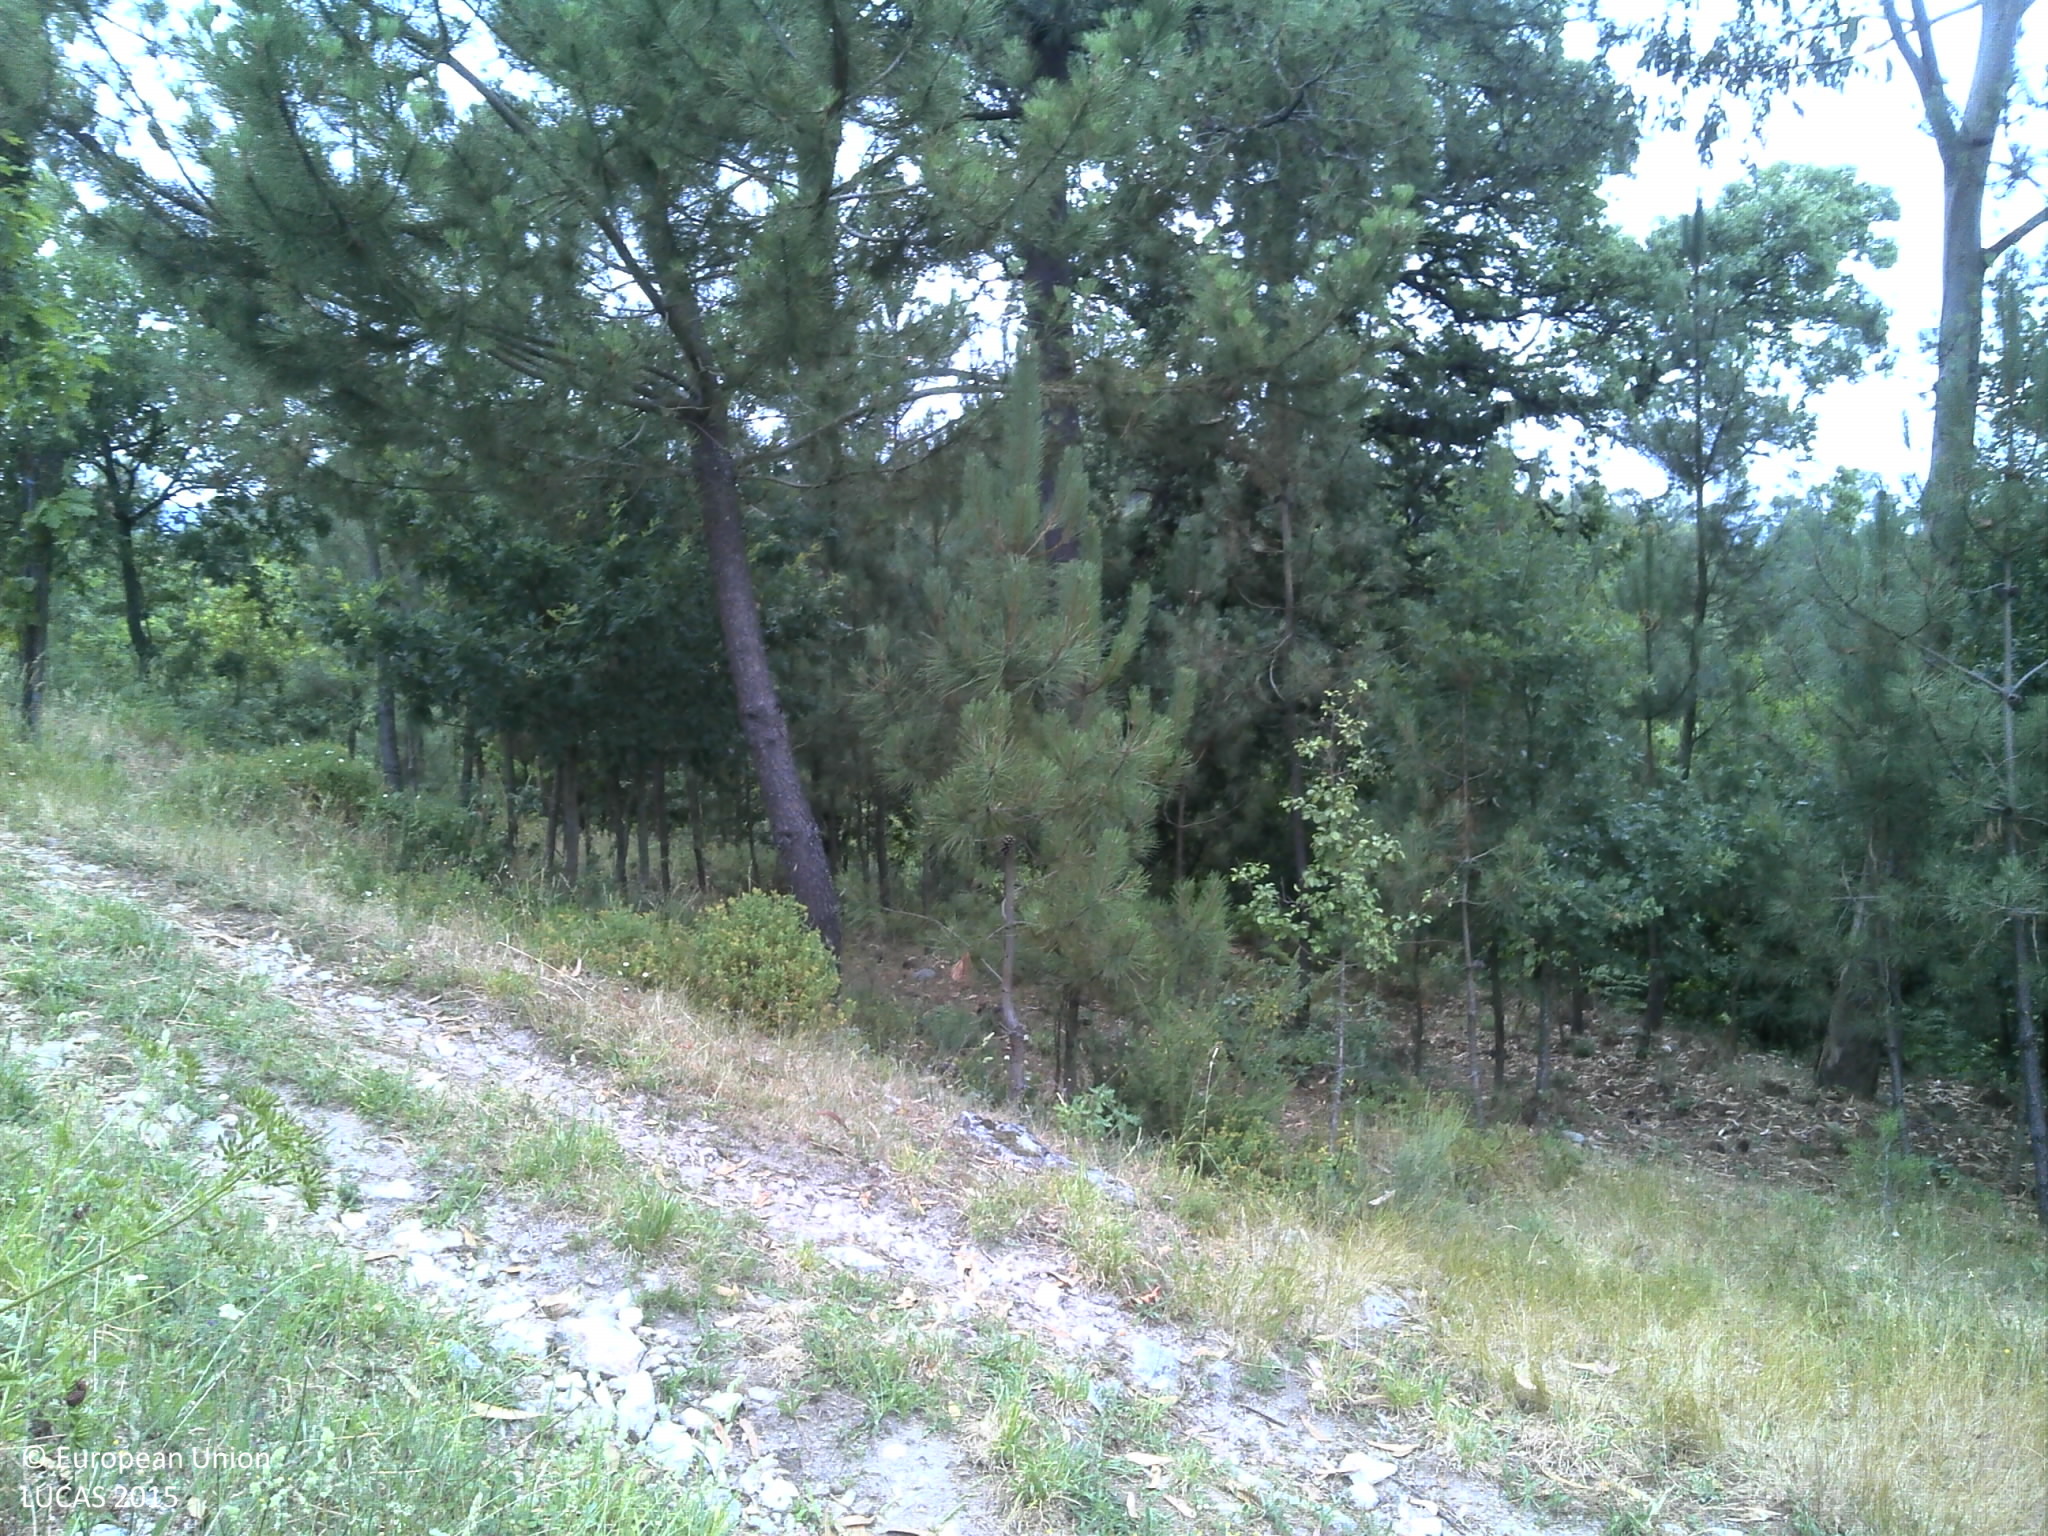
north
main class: Grassland
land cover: Grassland without tree/shrub cover
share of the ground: 50 - 75 %
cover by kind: herbaceous plants 75 %, unconsolidated bare surface 25 %
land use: Agriculture (excluding fallow land and kitchen gardens)
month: June
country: PT
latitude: 40.7844
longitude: -8.3033
